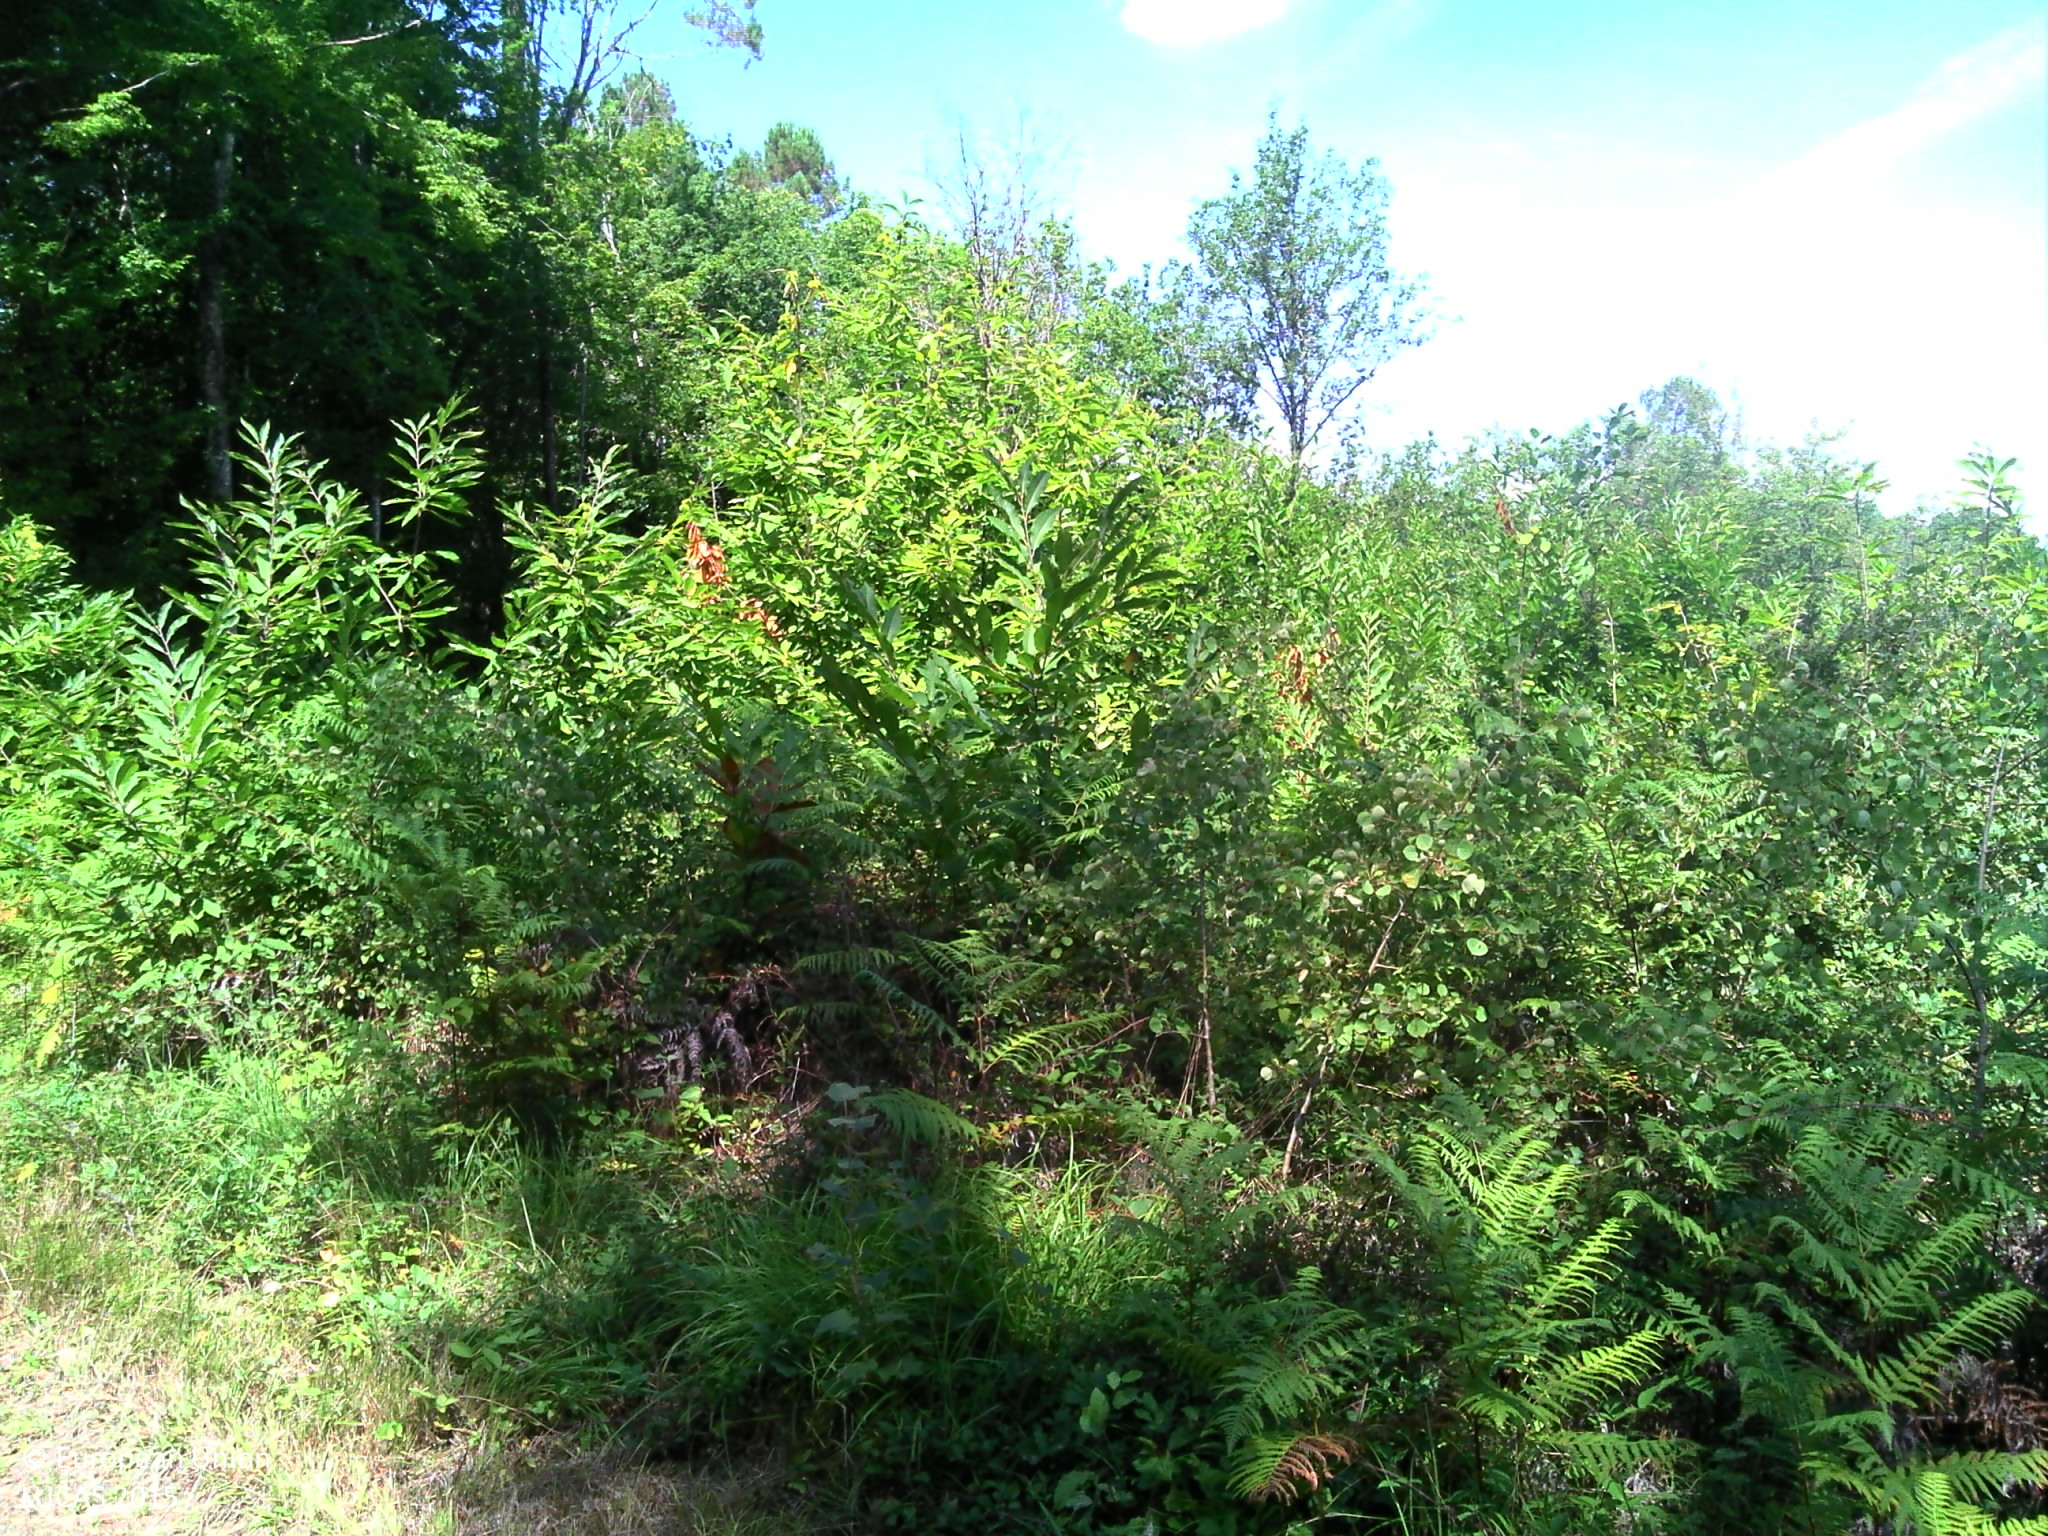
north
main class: Woodland
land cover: Pine dominated mixed woodland
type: coniferous forest of the mediterranean region
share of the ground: 25 - 50 %
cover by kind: herbaceous plants 40 %, broadleaved forest trees 30 %, shrubs 20 %, coniferous forest trees 10 %
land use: Forestry
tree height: < 5 m
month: August
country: FR
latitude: 45.2541
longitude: 0.6749
